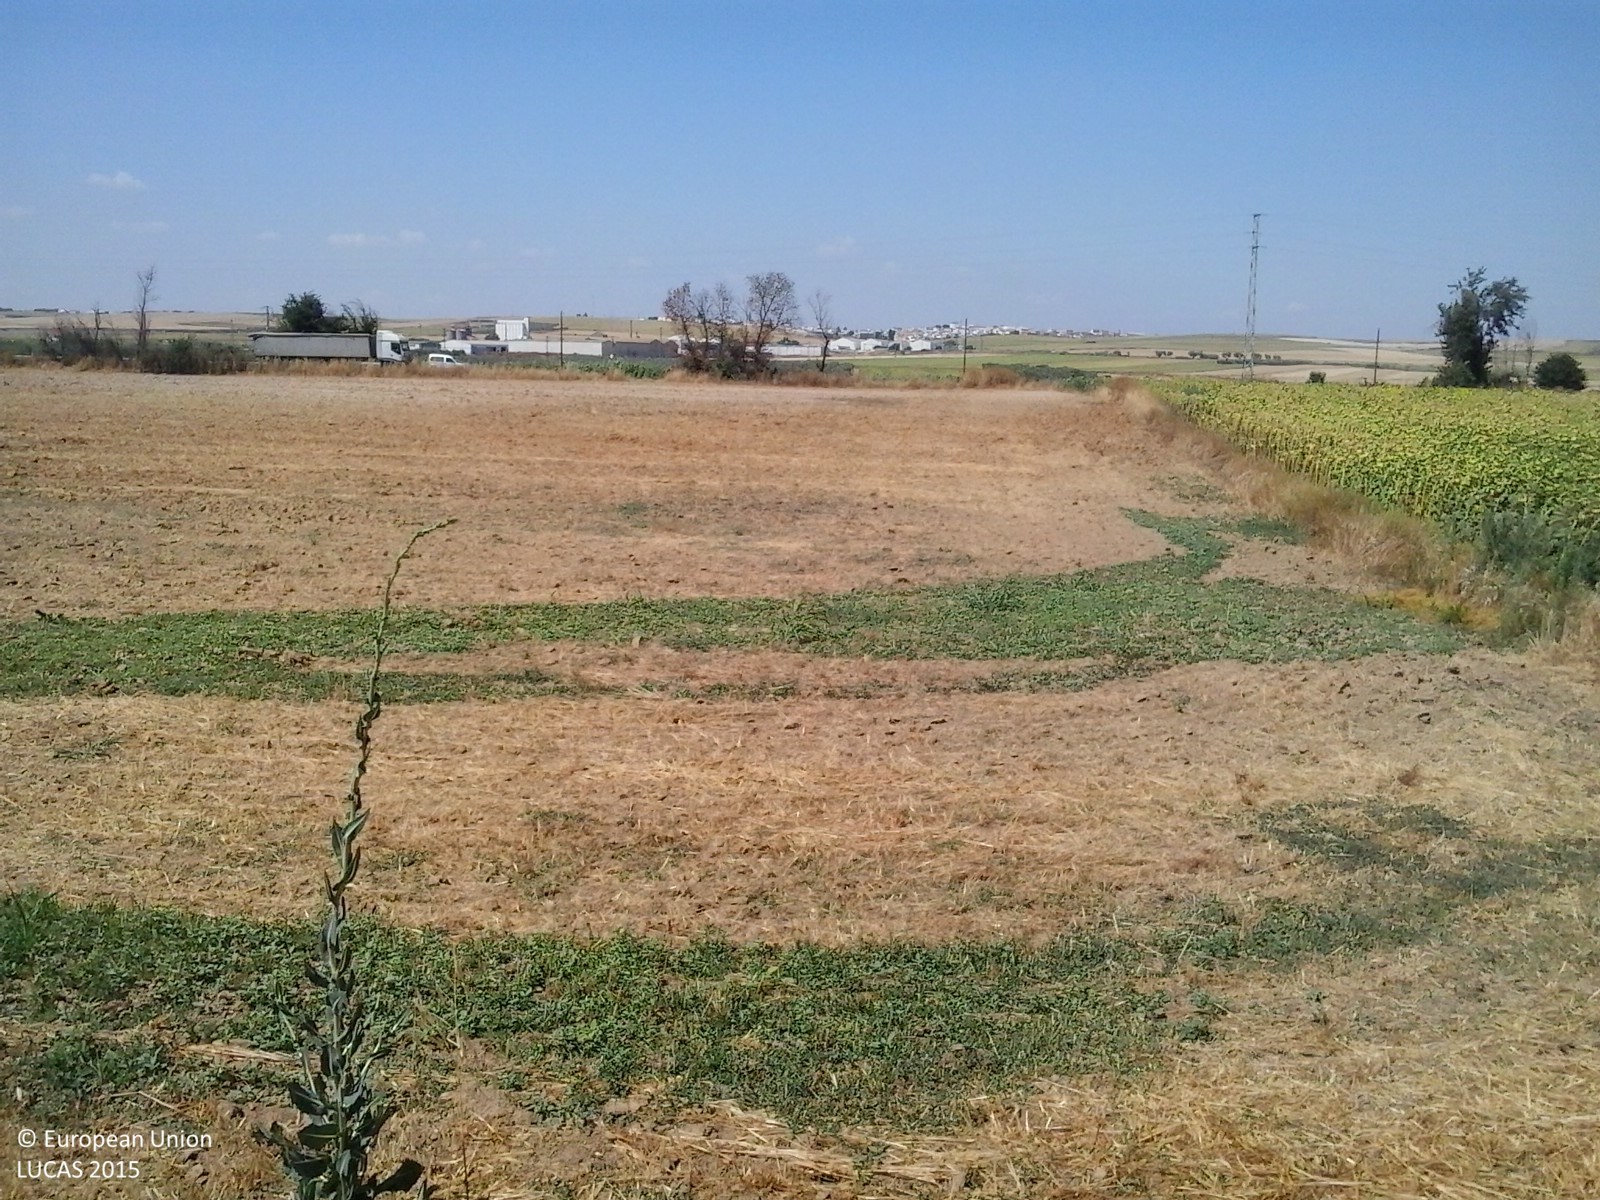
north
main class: Cropland
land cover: Sunflower
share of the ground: > 75 %
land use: Agriculture (excluding fallow land and kitchen gardens)
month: June
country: ES
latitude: 37.3843
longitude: -6.3957
